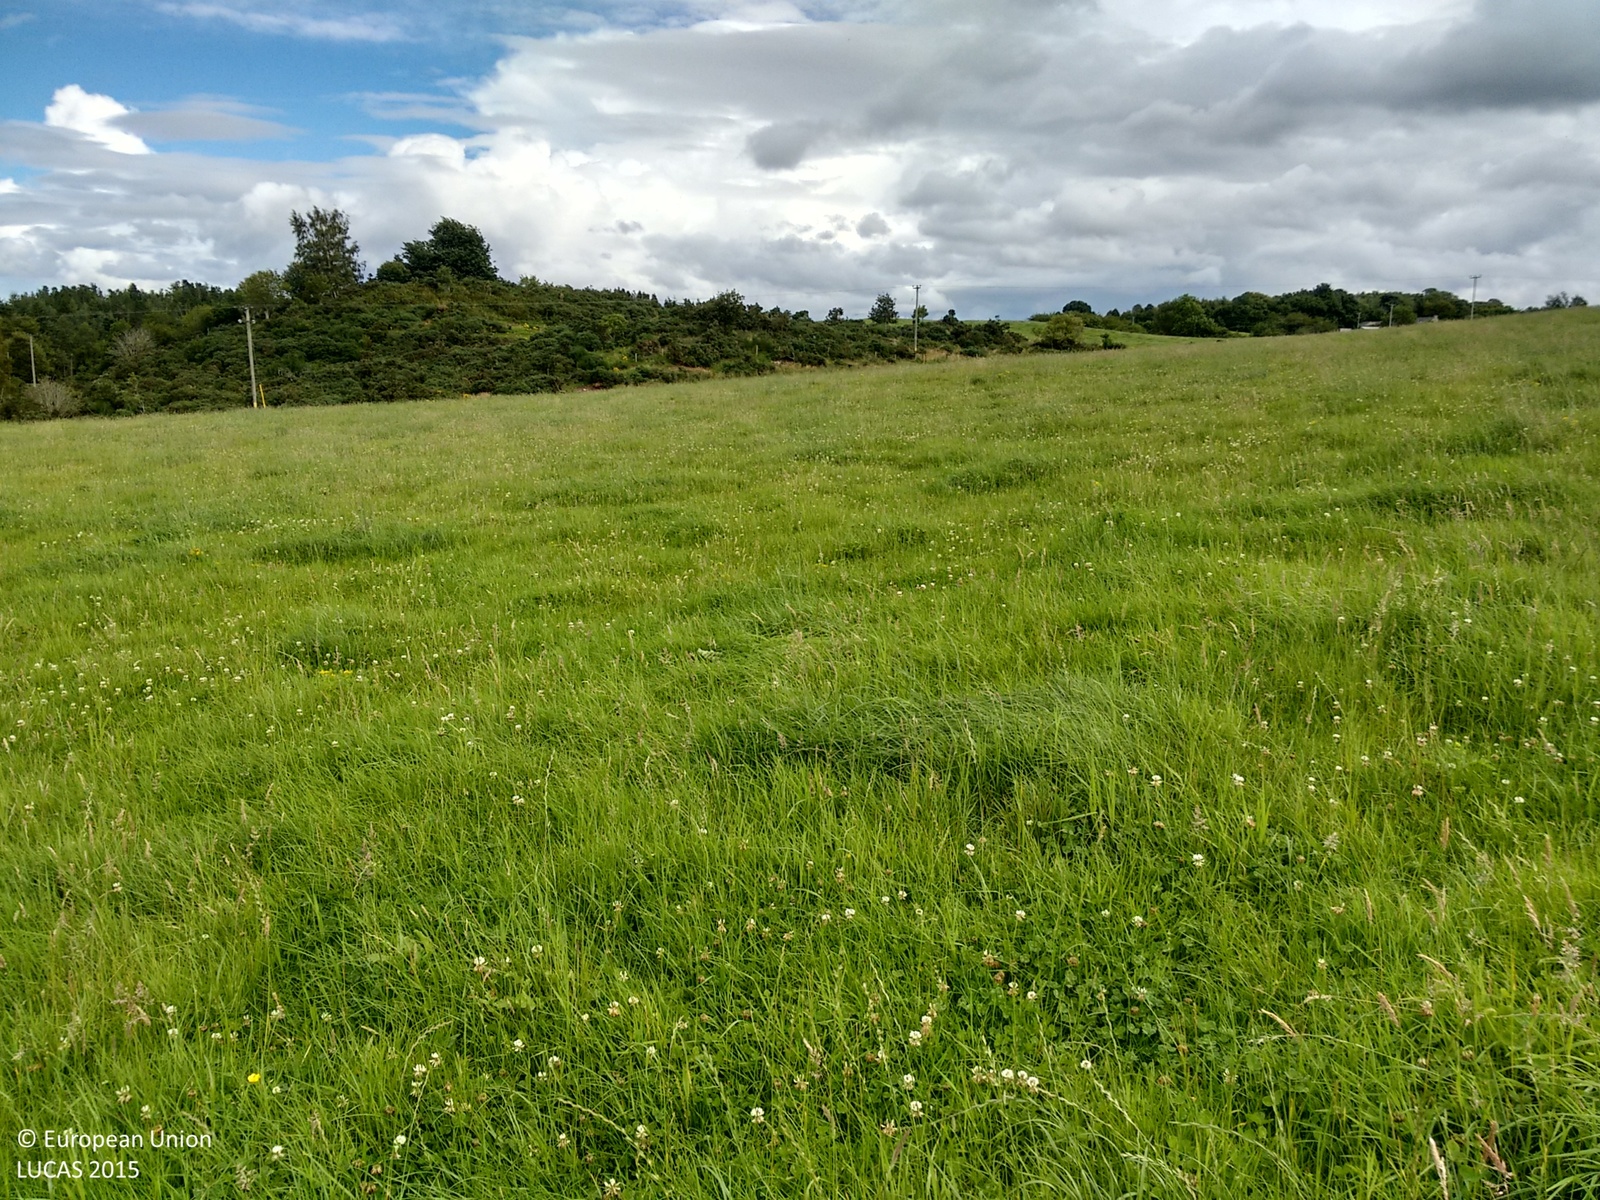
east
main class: Grassland
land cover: Grassland without tree/shrub cover
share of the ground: > 75 %
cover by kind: herbaceous plants 100 %
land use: Agriculture (excluding fallow land and kitchen gardens)
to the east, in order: Grassland without tree/shrub cover; Fences; Shrubland without tree cover; Electric lines; Shrubland with sparse tree cover; Grassland without tree/shrub cover
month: August
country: GB
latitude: 57.5988
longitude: -3.4038
